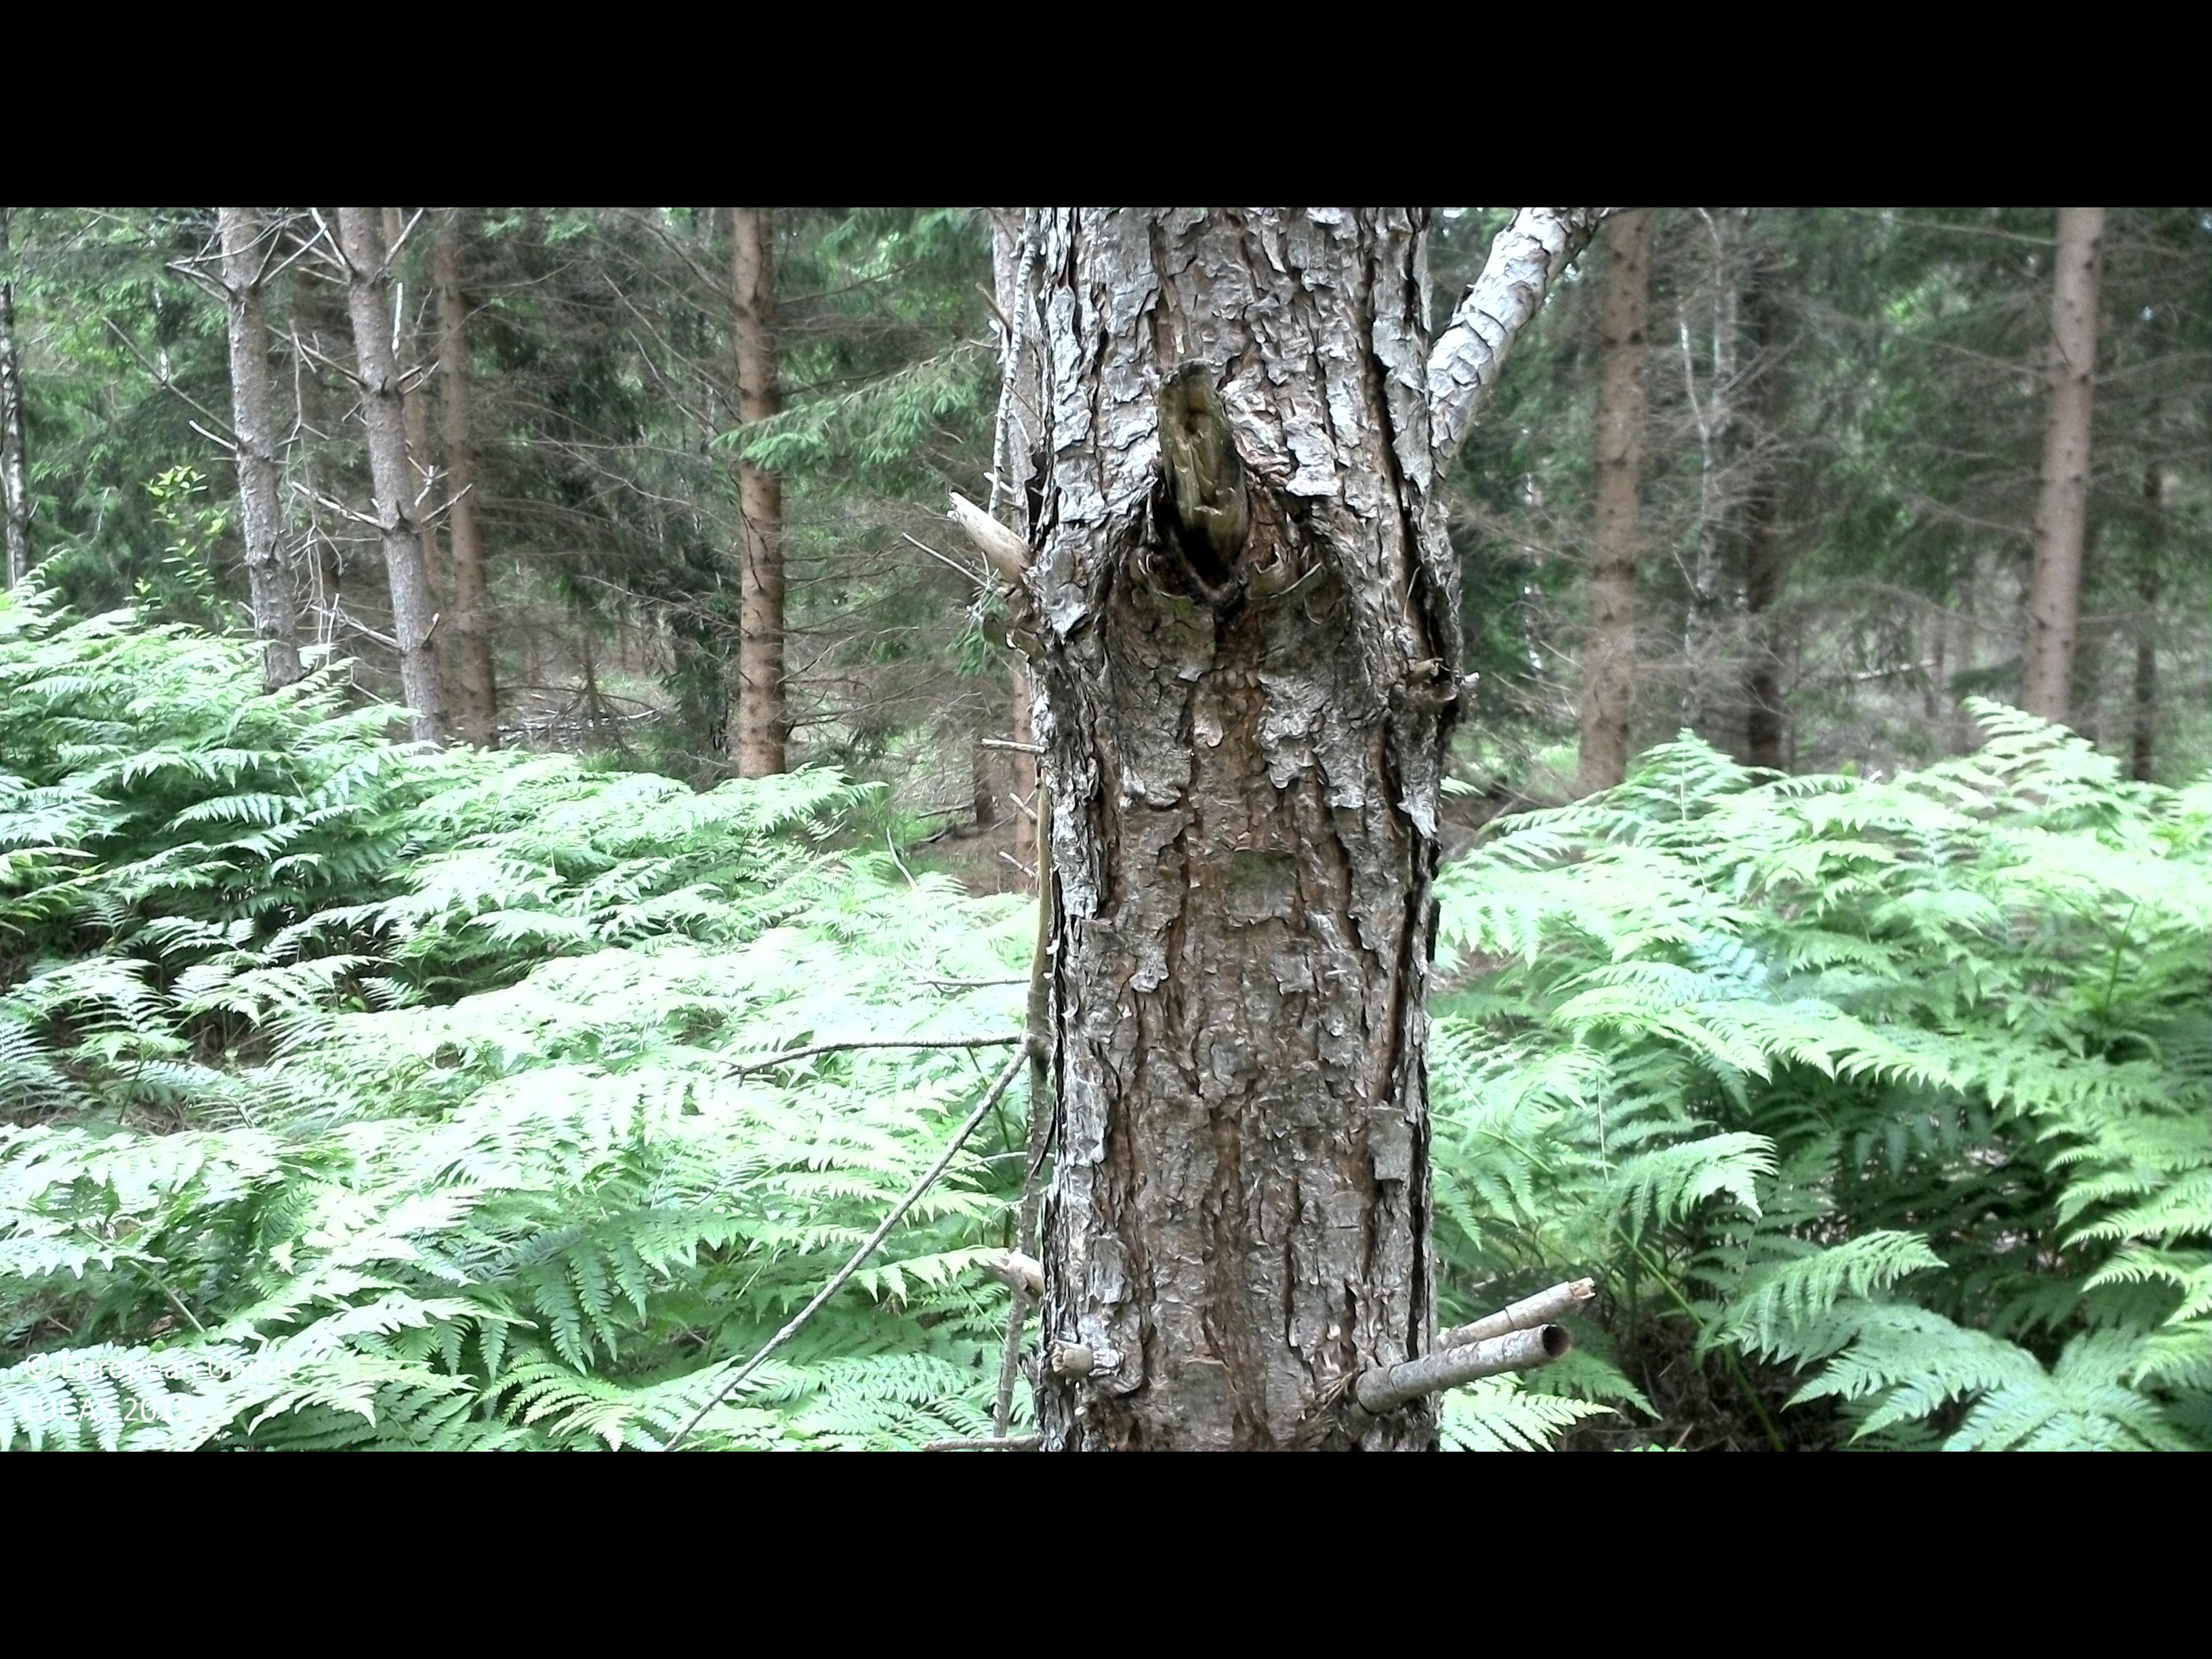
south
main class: Woodland
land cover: Pine dominated coniferous woodland
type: boreal forest
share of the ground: 50 - 75 %
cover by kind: coniferous forest trees 50 %, herbaceous plants 40 %, broadleaved forest trees 5 %, lichens and mosses 5 %
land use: Forestry
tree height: > 5 m
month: June
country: SE
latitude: 56.4940
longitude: 16.0915
